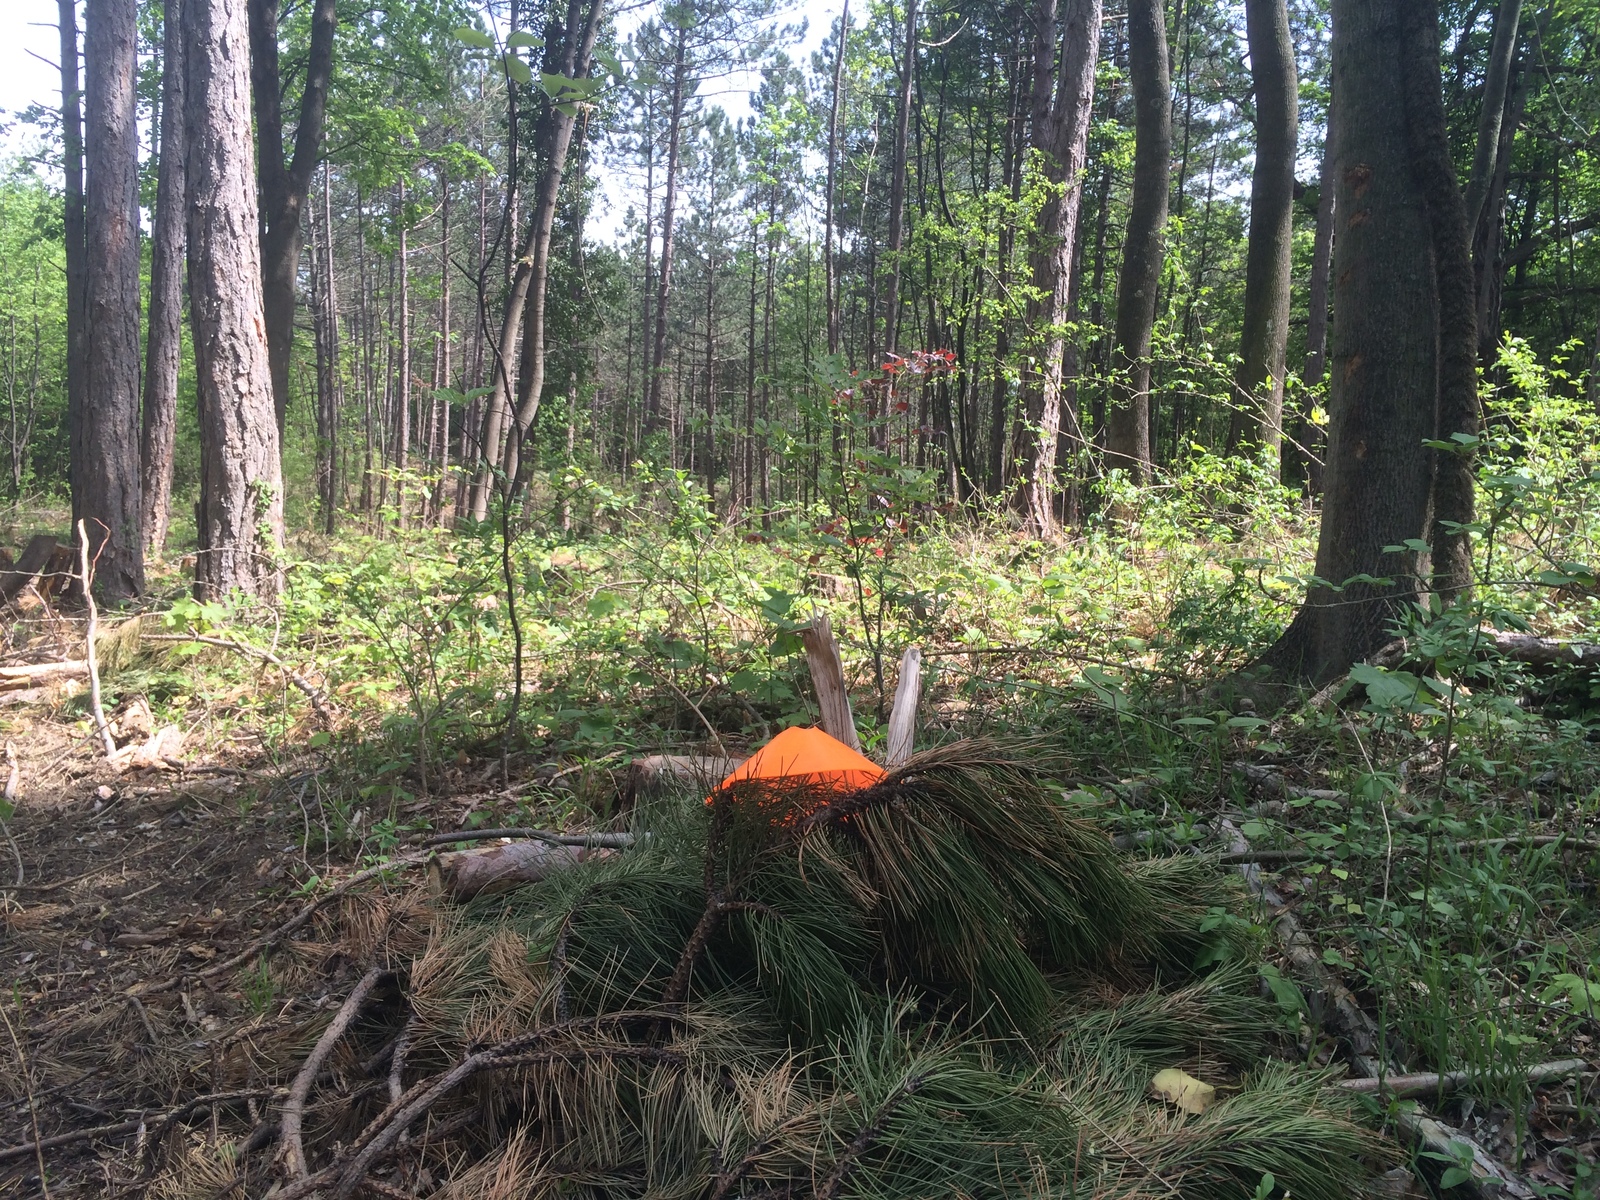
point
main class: Woodland
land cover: Pine dominated mixed woodland
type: alpine coniferous forest
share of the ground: > 75 %
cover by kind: coniferous forest trees 40 %, broadleaved forest trees 40 %, shrubs 10 %, herbaceous plants 10 %
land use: Forestry
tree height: > 5 m
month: May
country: AT
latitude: 47.9242
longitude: 16.1733
